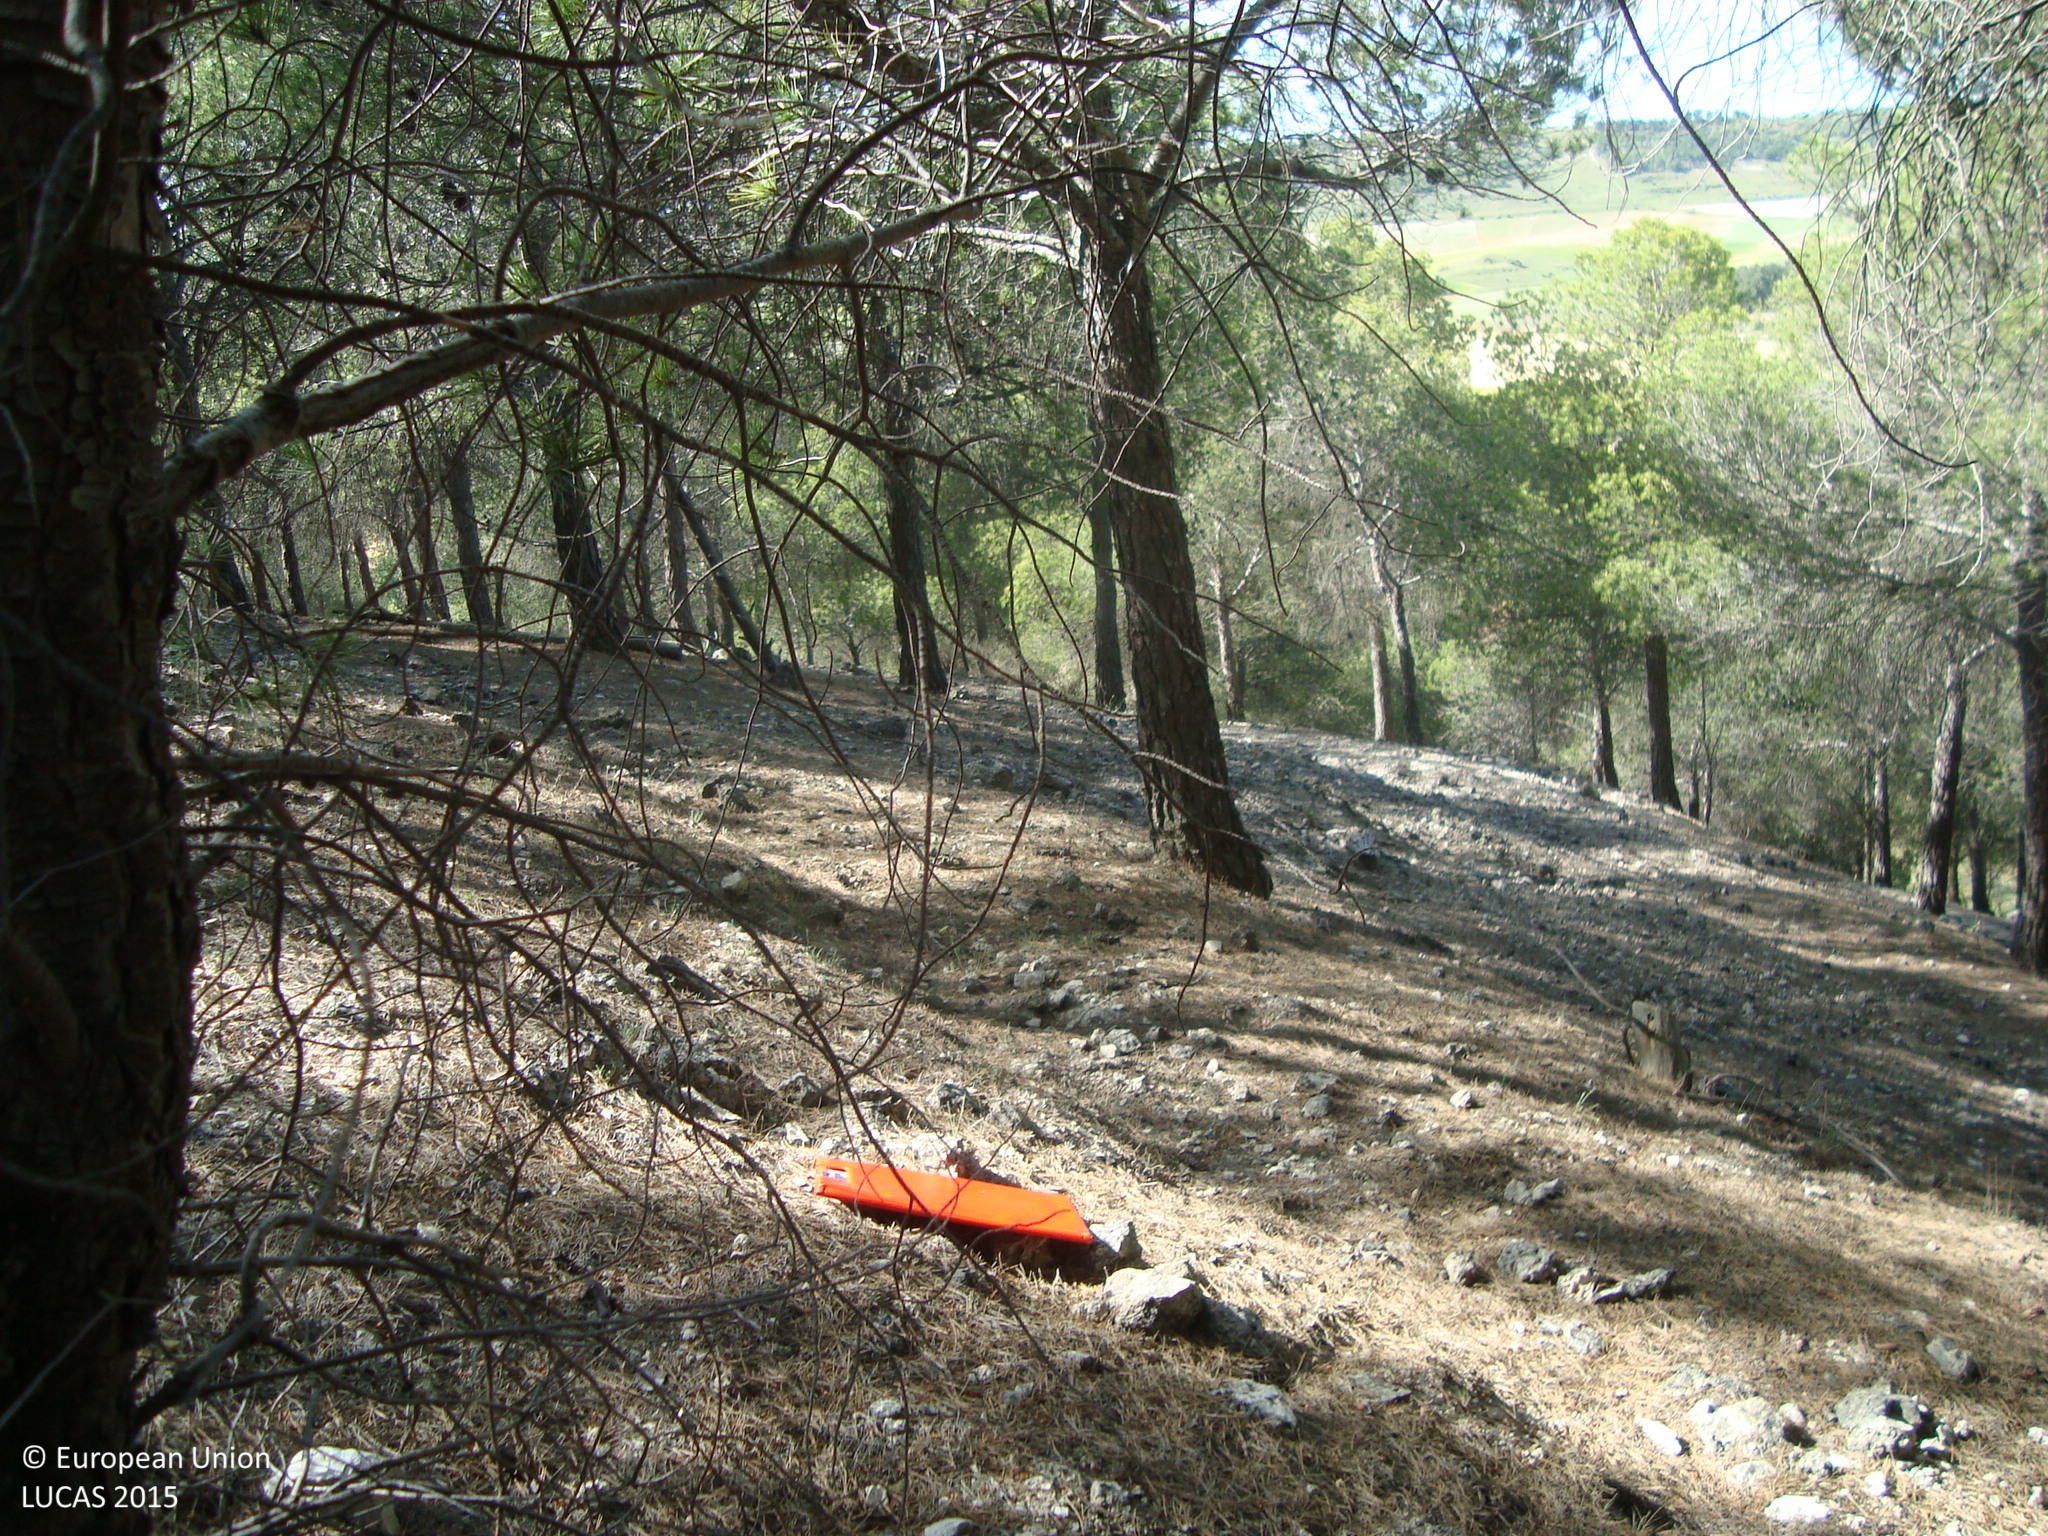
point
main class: Woodland
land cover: Pine dominated coniferous woodland
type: coniferous forest of the mediterranean region
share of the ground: > 75 %
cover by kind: coniferous forest trees 80 %, unconsolidated bare surface 10 %, shrubs 5 %, herbaceous plants 5 %
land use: Forestry
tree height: > 5 m
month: May
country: ES
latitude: 41.4208
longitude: -4.6258
